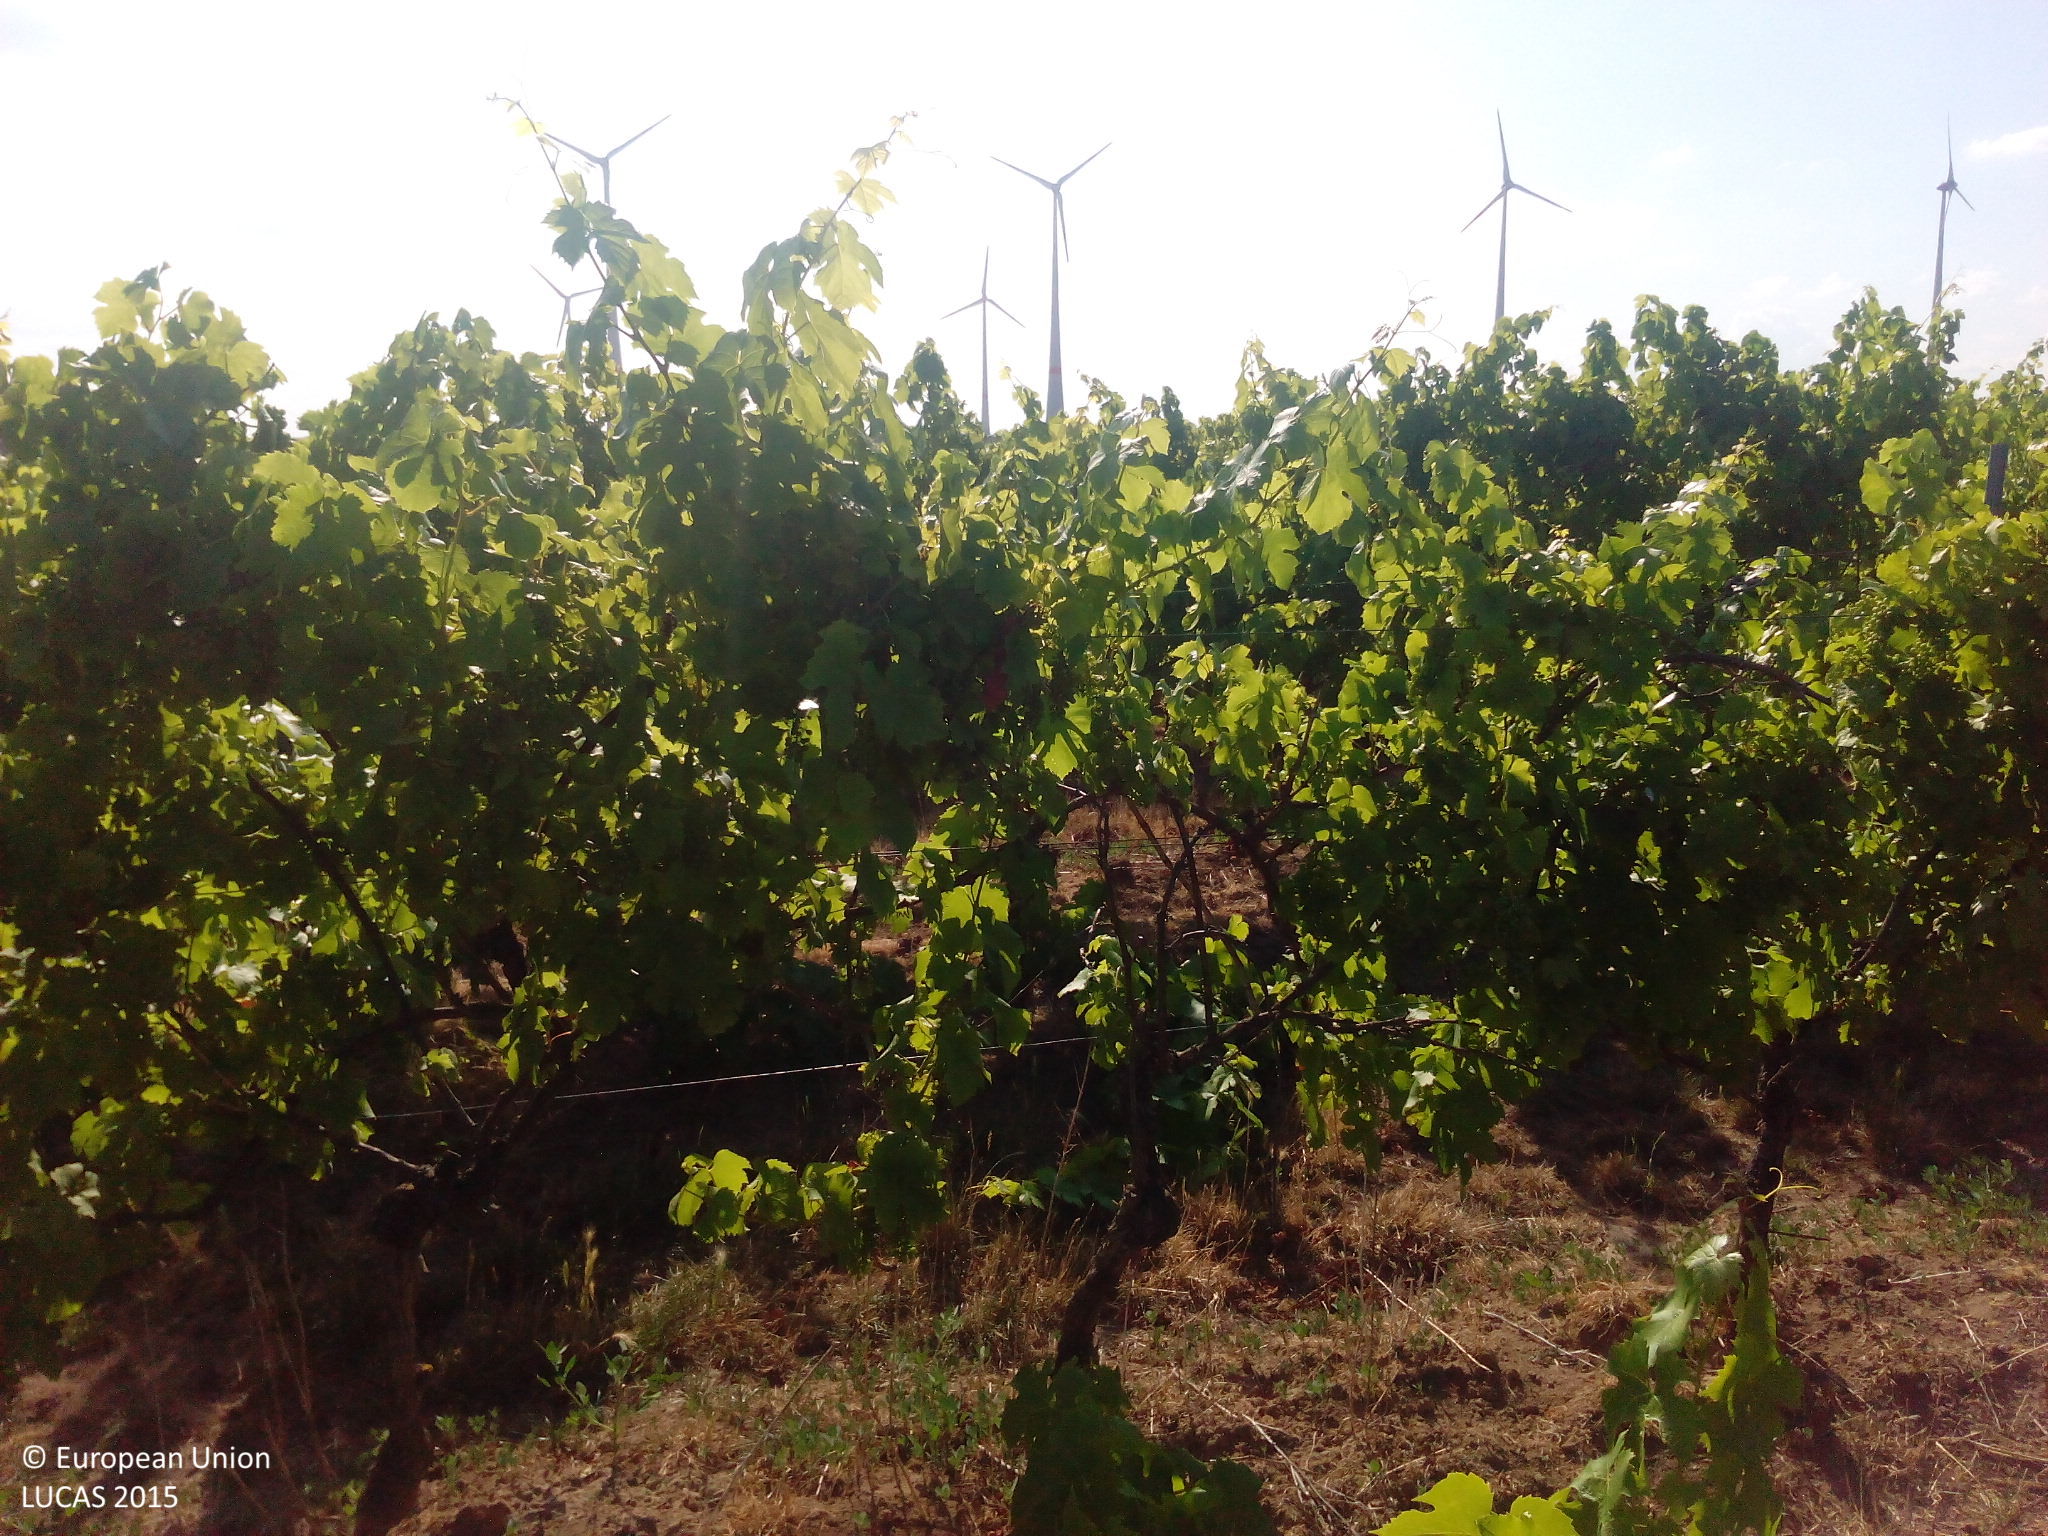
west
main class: Cropland
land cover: Vineyards
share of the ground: > 75 %
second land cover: Grassland without tree/shrub cover
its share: 50 - 75 %
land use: Agriculture (excluding fallow land and kitchen gardens)
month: July
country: DE
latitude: 49.8275
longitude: 8.1516
